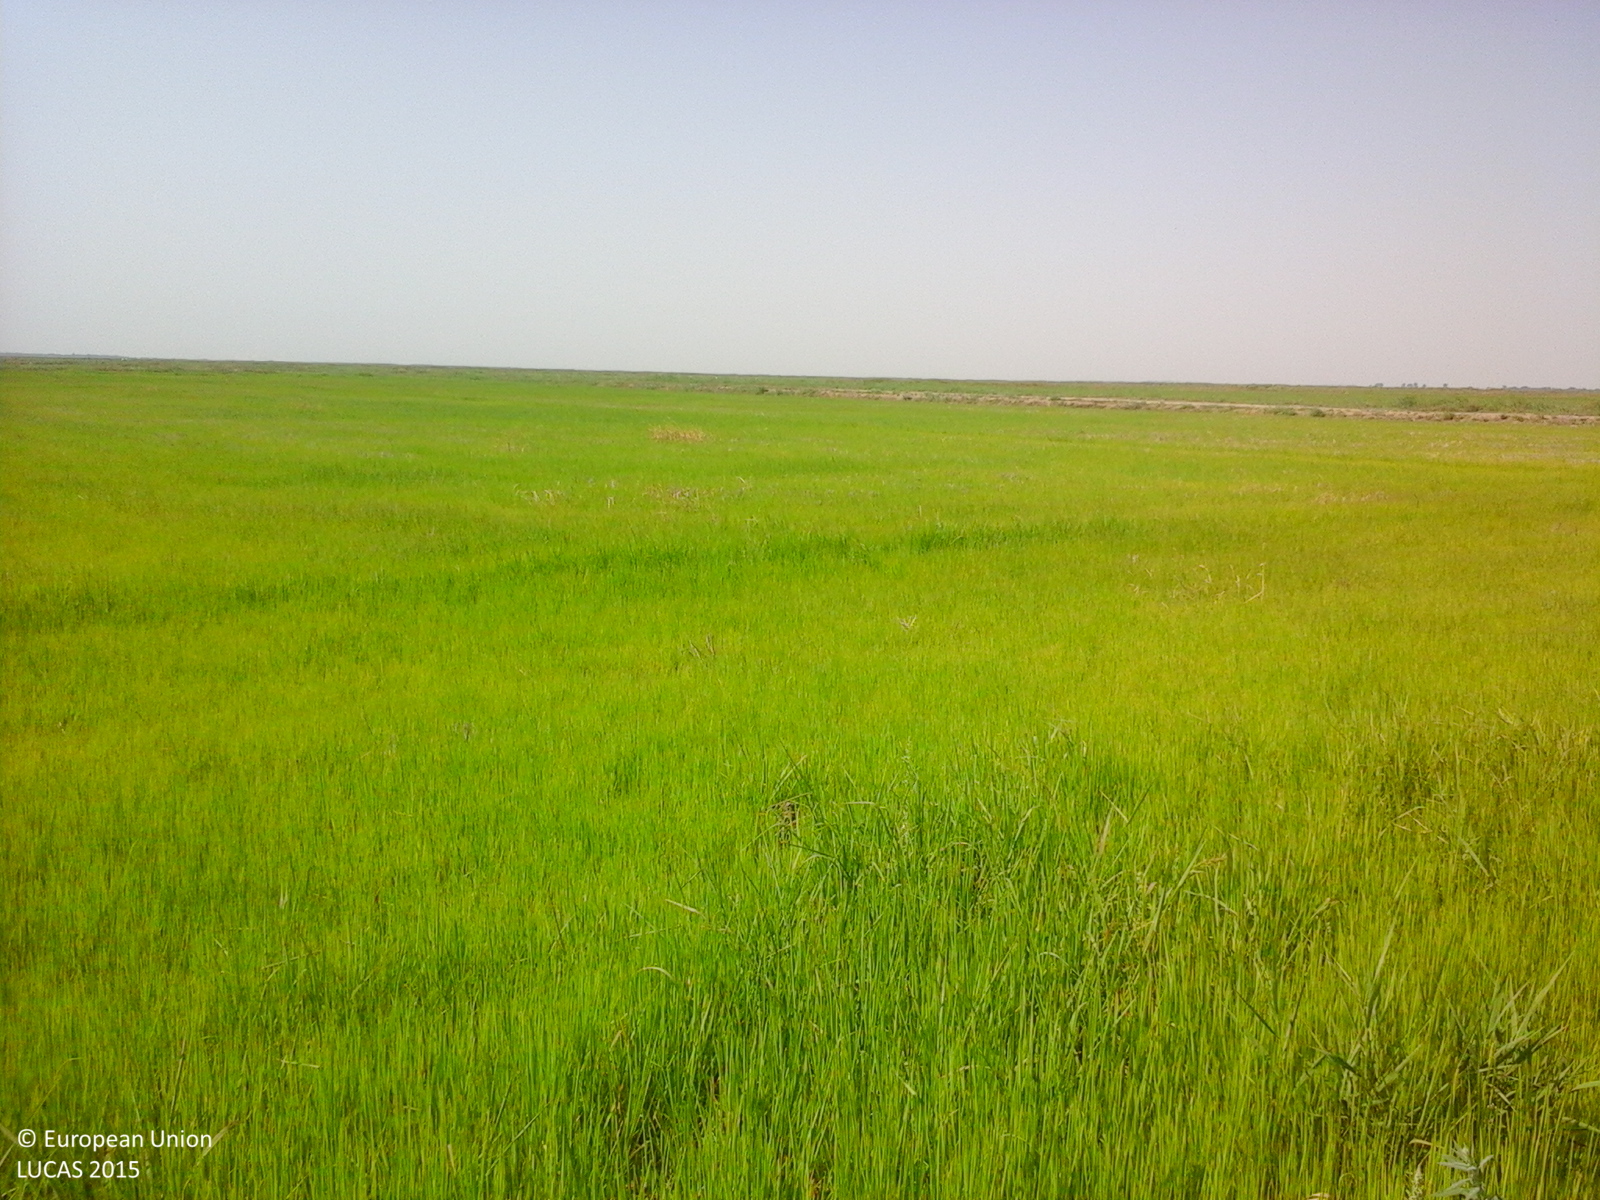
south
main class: Cropland
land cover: Rice
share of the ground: > 75 %
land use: Agriculture (excluding fallow land and kitchen gardens)
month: August
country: RO
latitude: 45.4035
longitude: 27.7525
